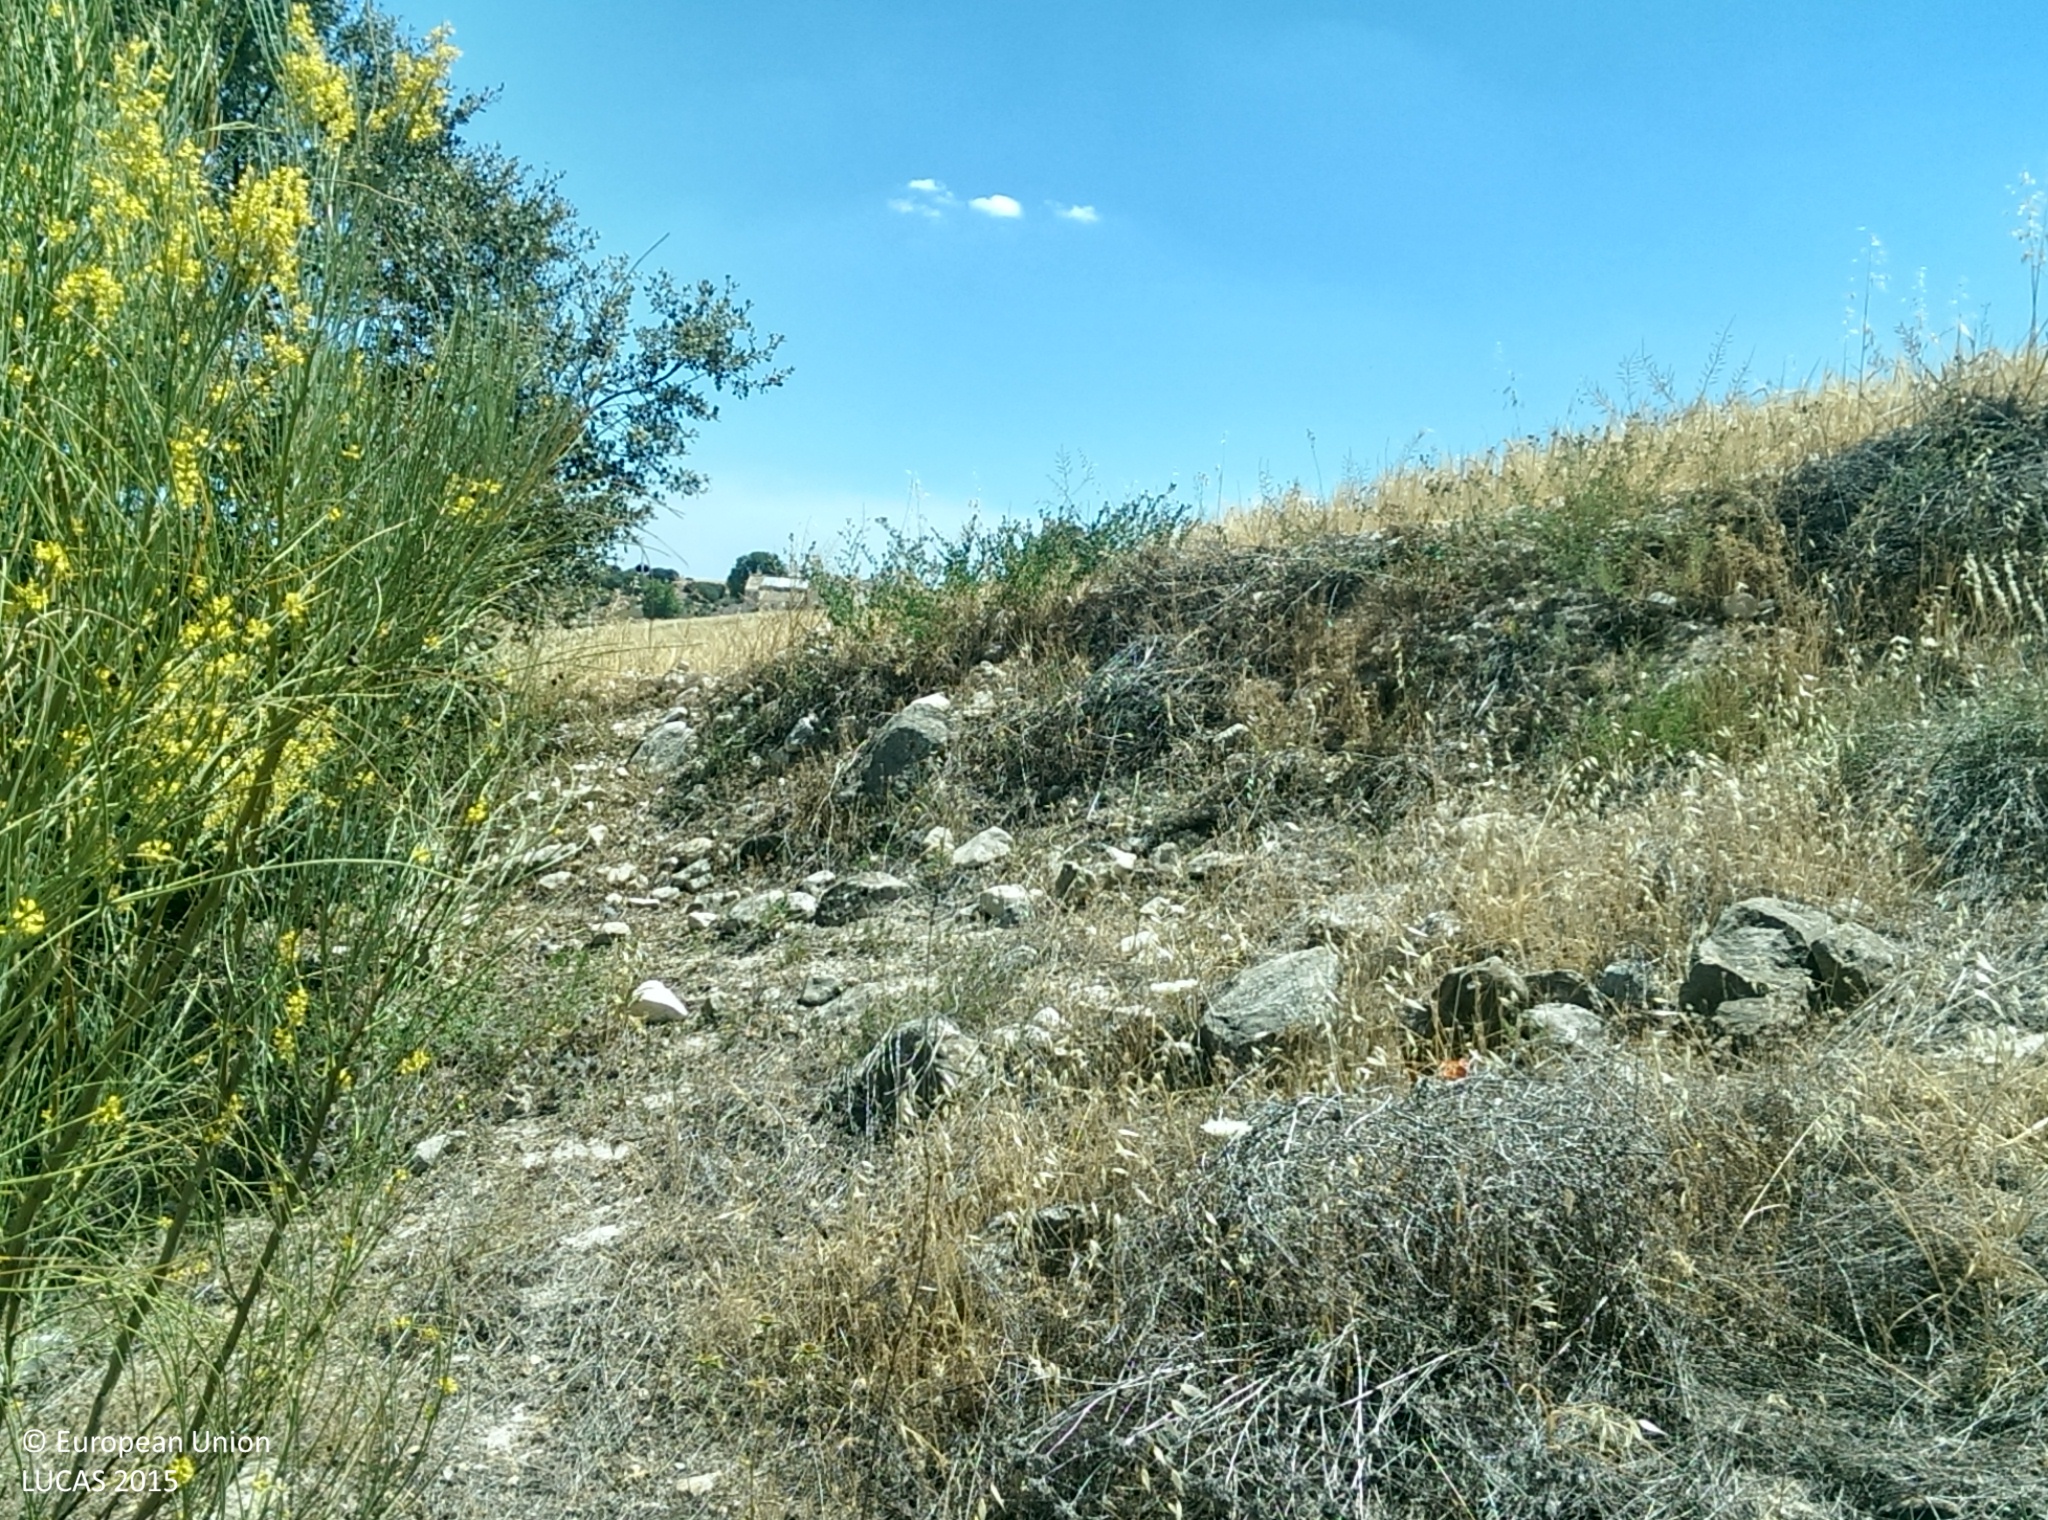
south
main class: Shrubland
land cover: Shrubland with sparse tree cover
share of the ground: 50 - 75 %
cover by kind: shrubs 50 %, herbaceous plants 40 %, broadleaved forest trees 5 %, unconsolidated bare surface 5 %
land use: Semi-natural and natural areas not in use
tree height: < 5 m
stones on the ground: 10 - 25 %
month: June
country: ES
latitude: 37.5588
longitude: -3.3168
